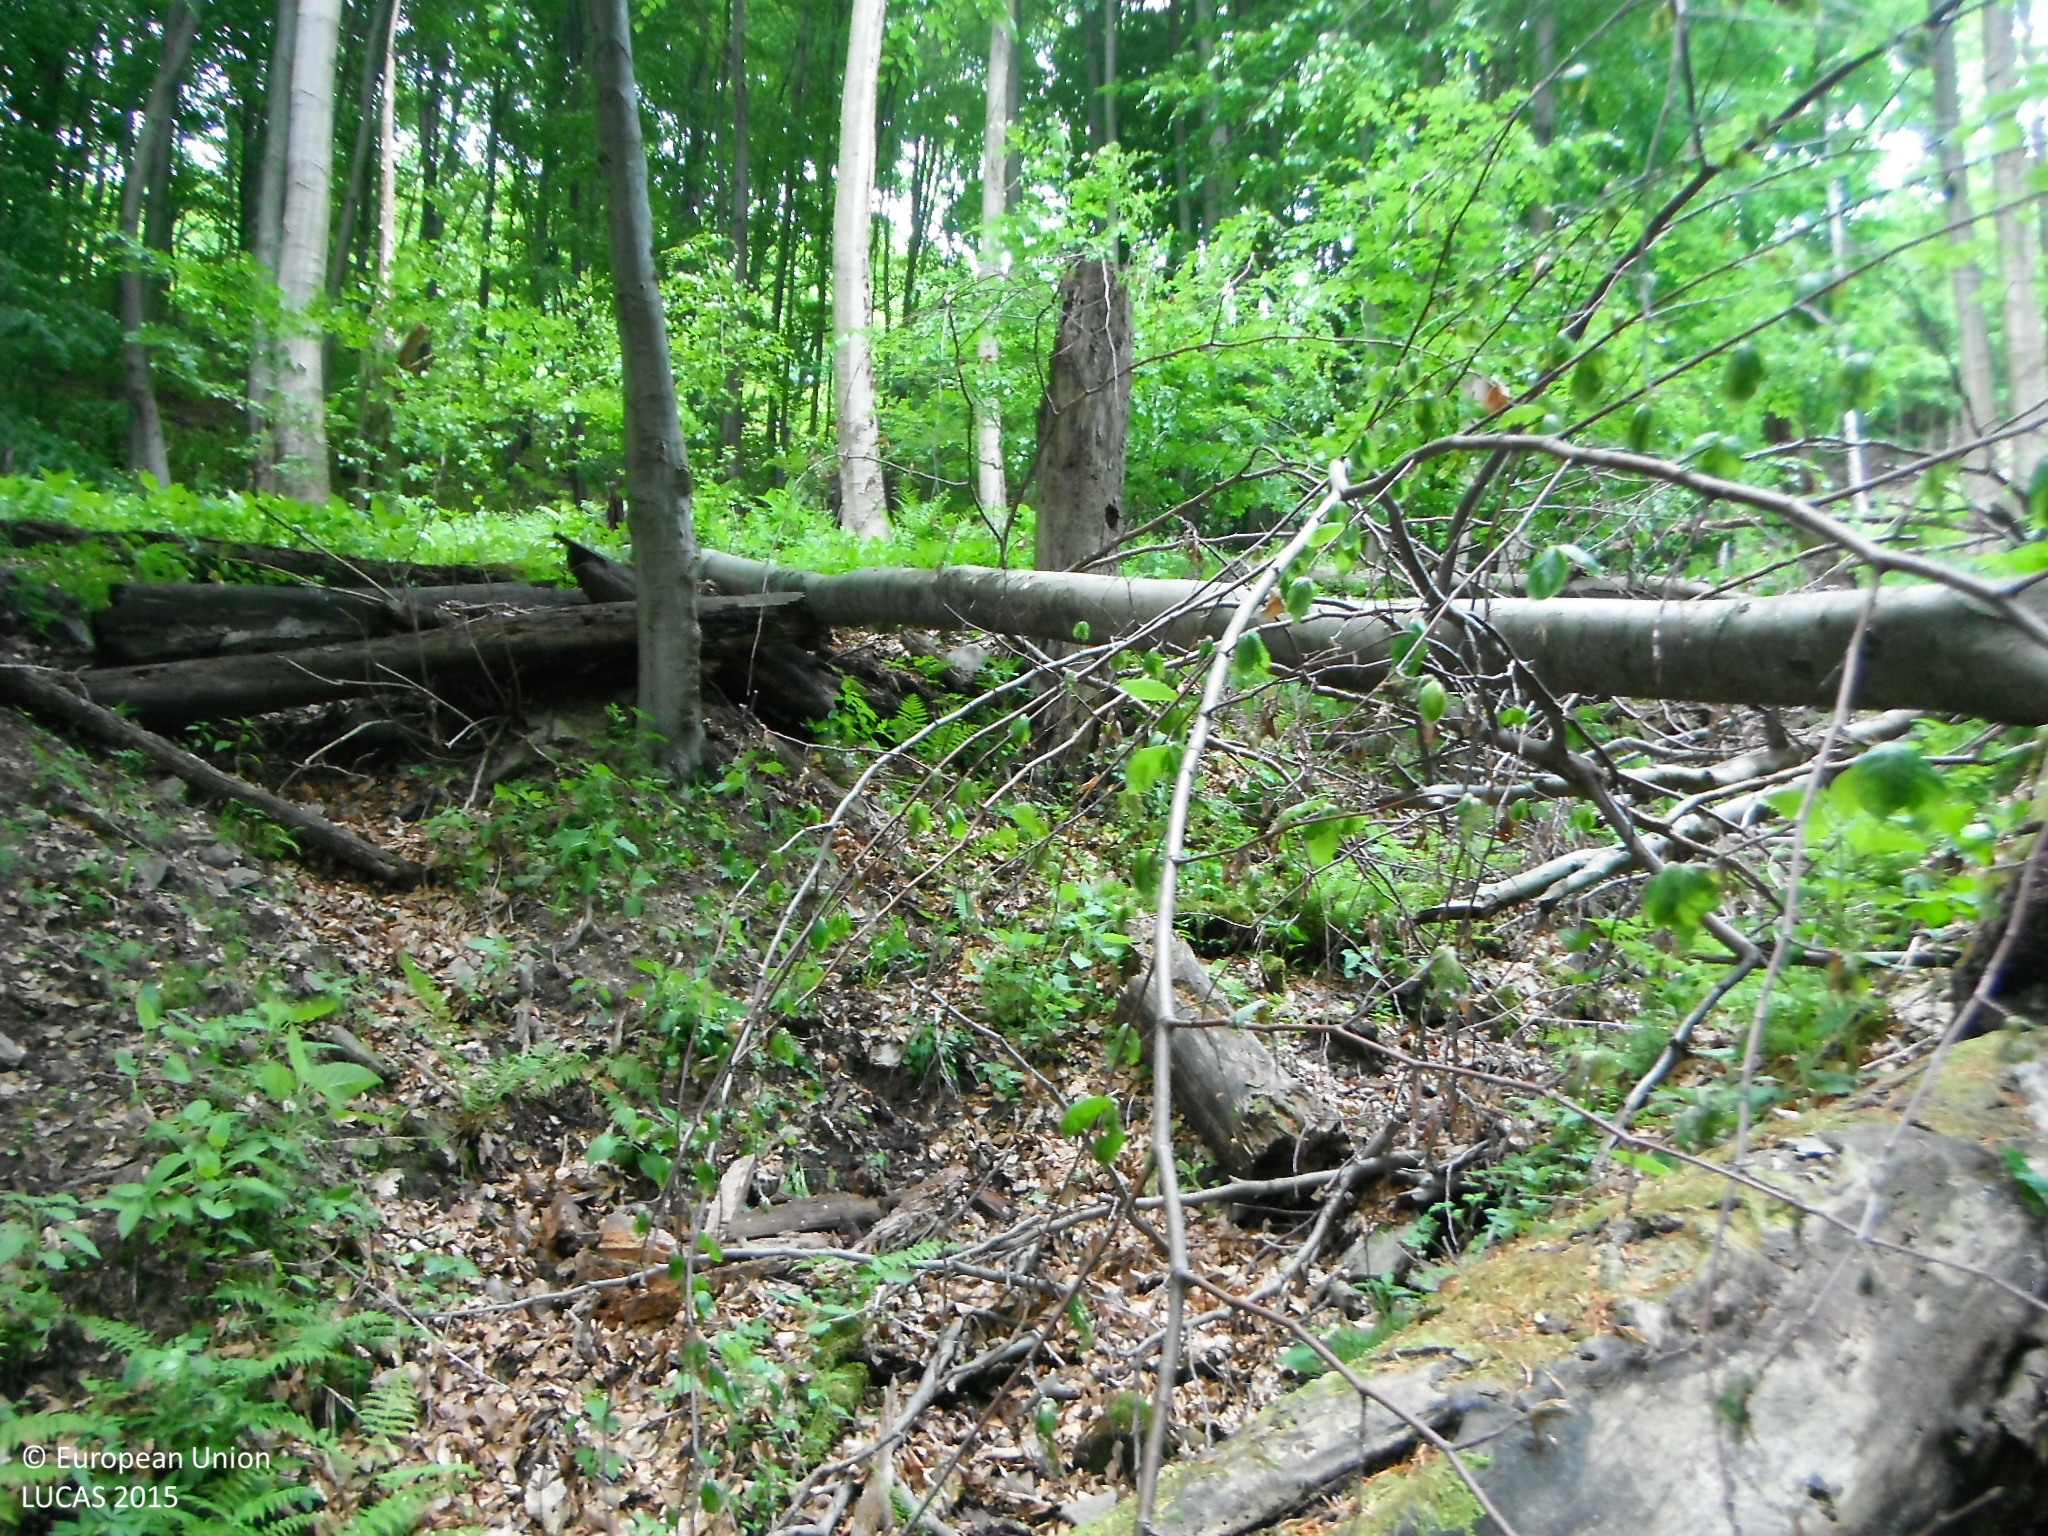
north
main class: Woodland
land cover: Broadleaved woodland
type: beech forest
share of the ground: > 75 %
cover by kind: broadleaved forest trees 50 %, shrubs 20 %, unconsolidated bare surface 20 %, herbaceous plants 10 %
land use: Forestry
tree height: > 5 m
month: May
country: SK
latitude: 48.3492
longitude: 17.2010
